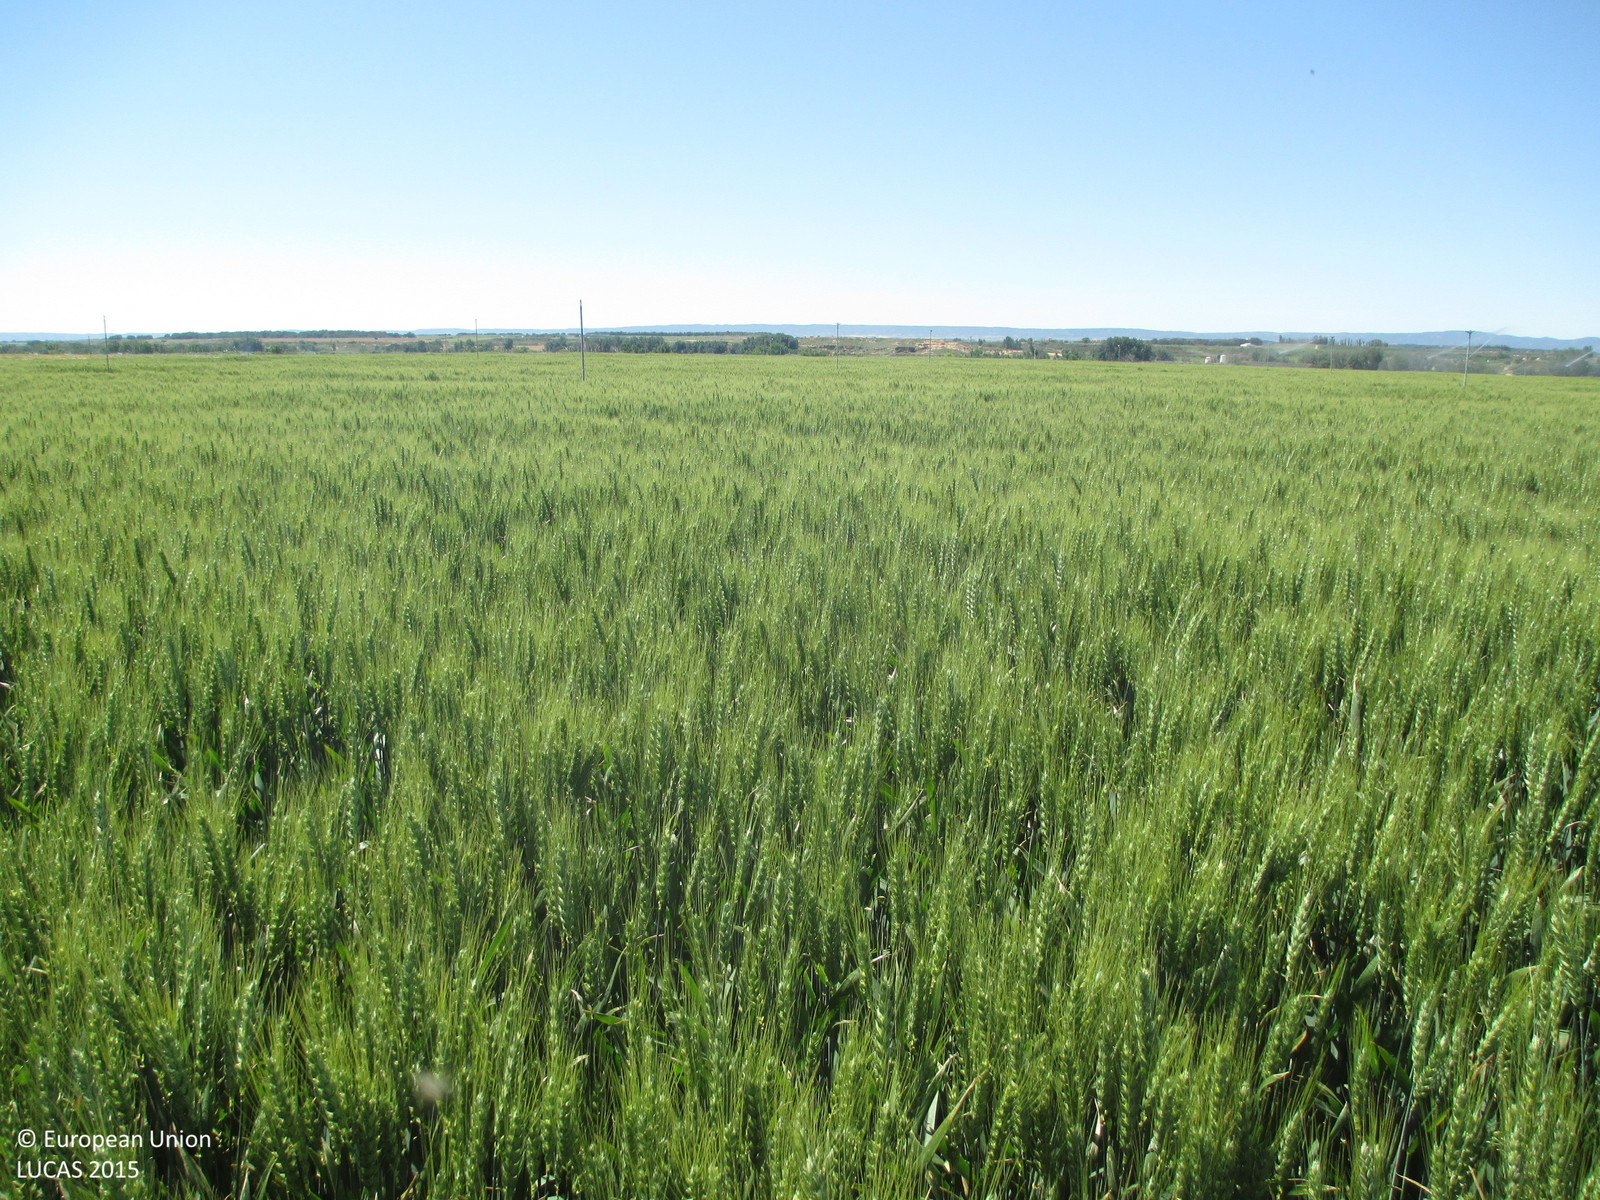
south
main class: Cropland
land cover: Durum wheat
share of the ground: > 75 %
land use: Agriculture (excluding fallow land and kitchen gardens)
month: May
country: ES
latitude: 41.8422
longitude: -0.2435
